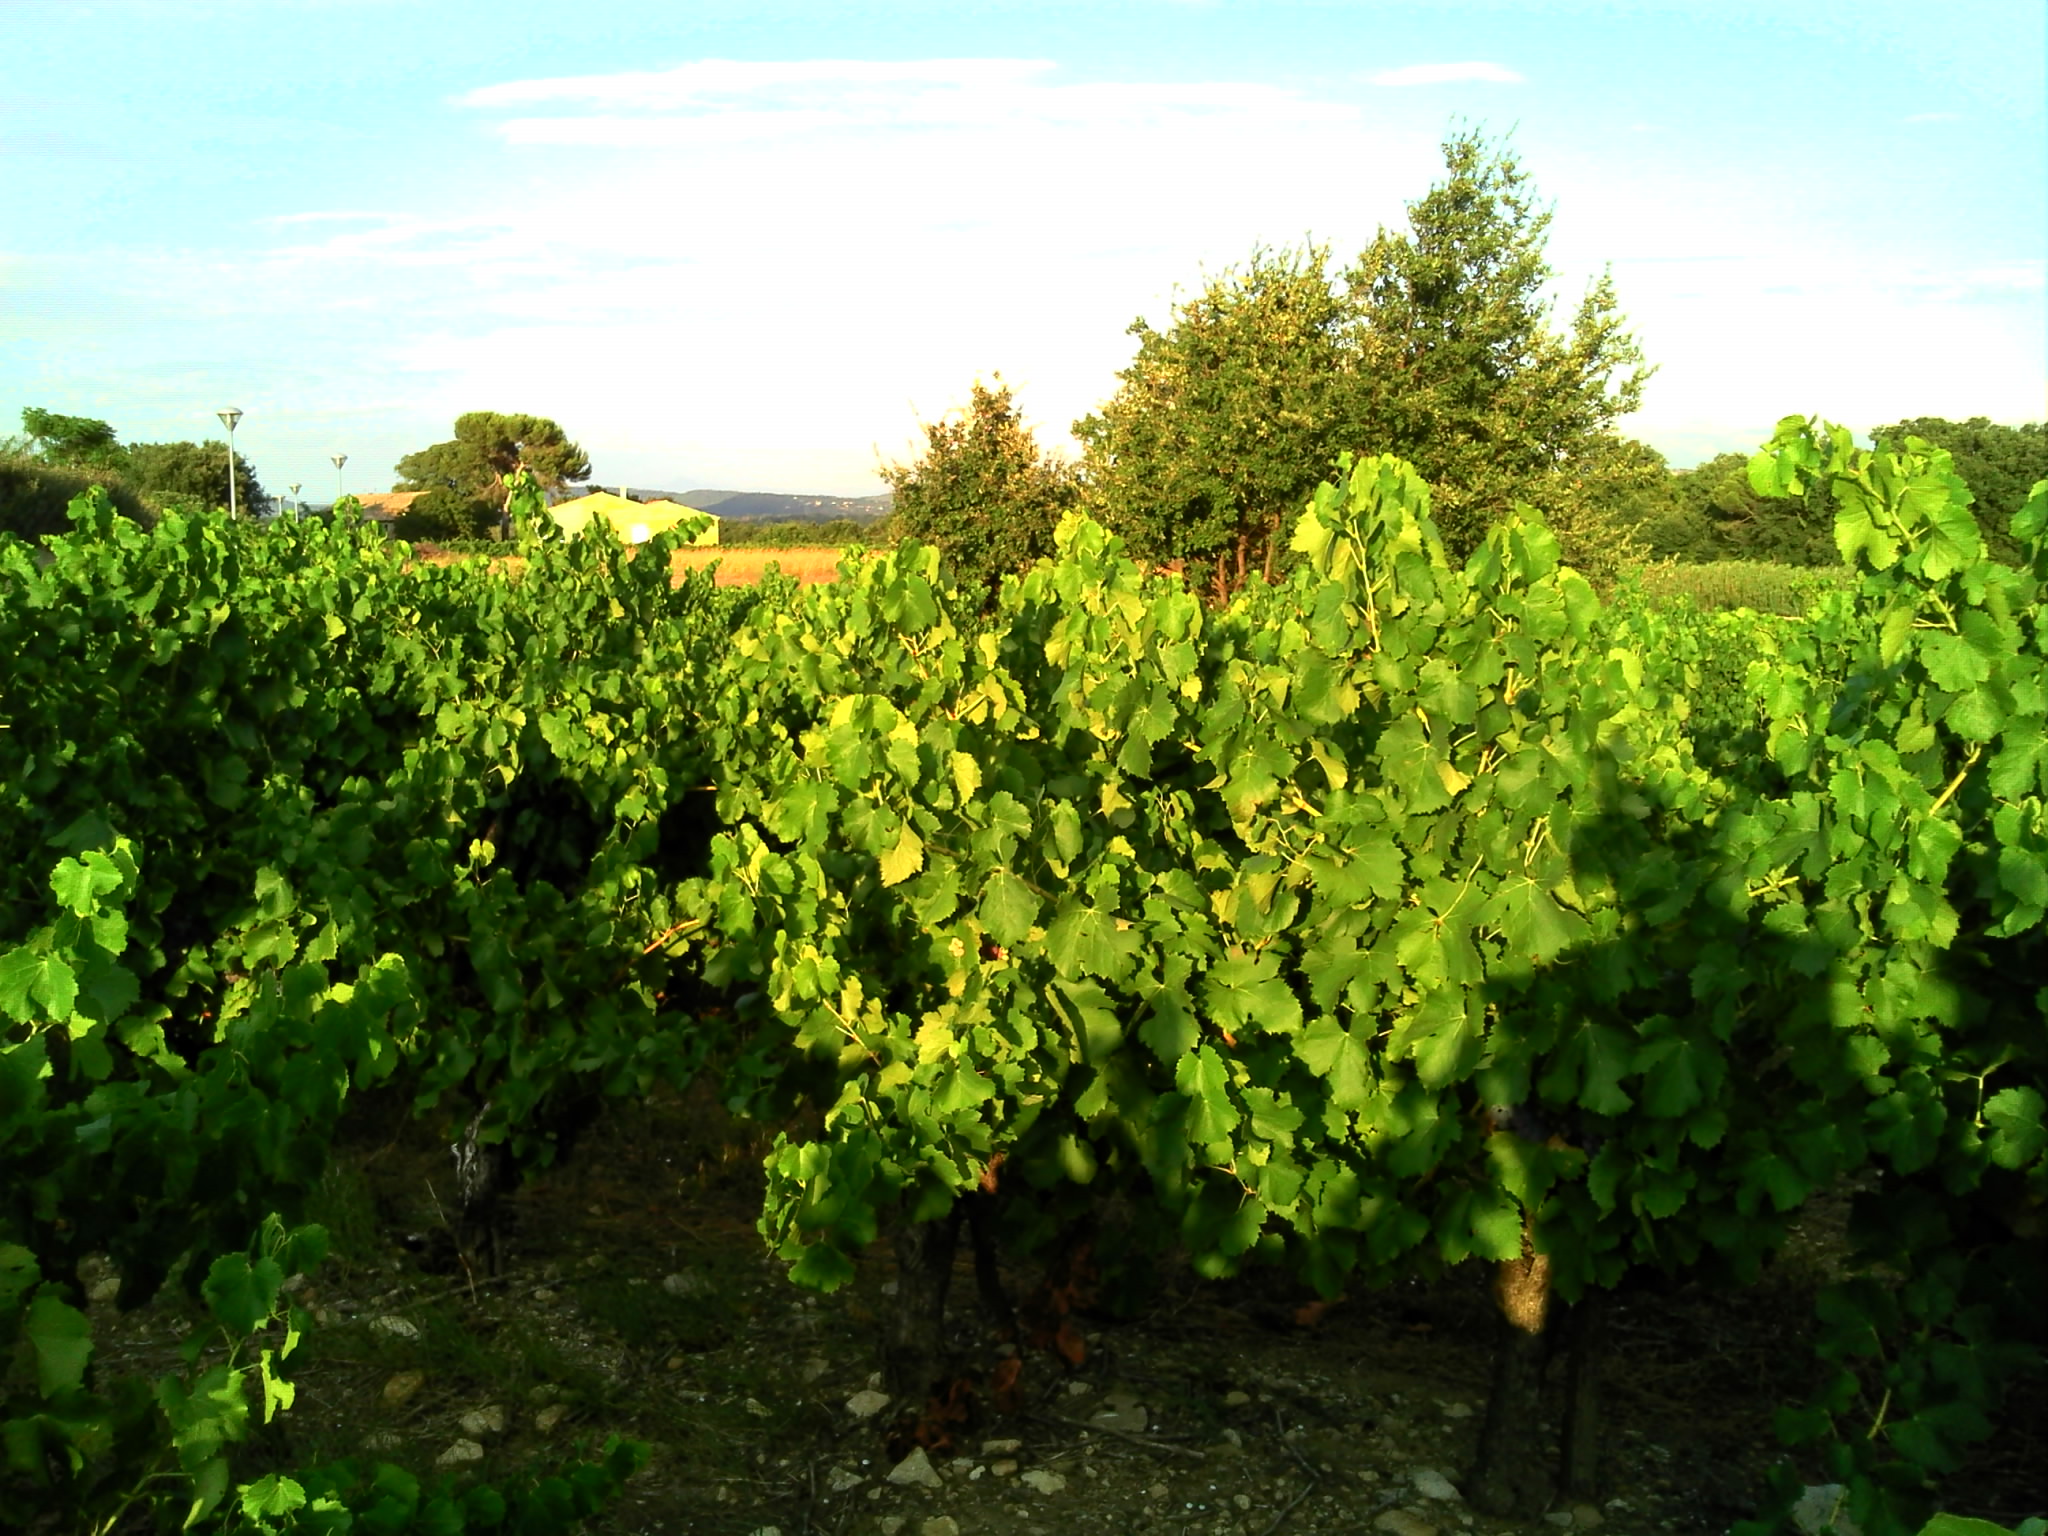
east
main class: Cropland
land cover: Vineyards
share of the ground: 50 - 75 %
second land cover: Spontaneously vegetated surfaces
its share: 25 - 50 %
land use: Agriculture (excluding fallow land and kitchen gardens)
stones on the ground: < 10 %
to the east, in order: Vineyards; Spontaneously vegetated surfaces; Abandoned hedges; Spontaneously vegetated surfaces; Single bushes/trees; Spontaneously vegetated surfaces; Abandoned hedges; Vineyards
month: August
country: FR
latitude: 44.2300
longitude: 4.6368
